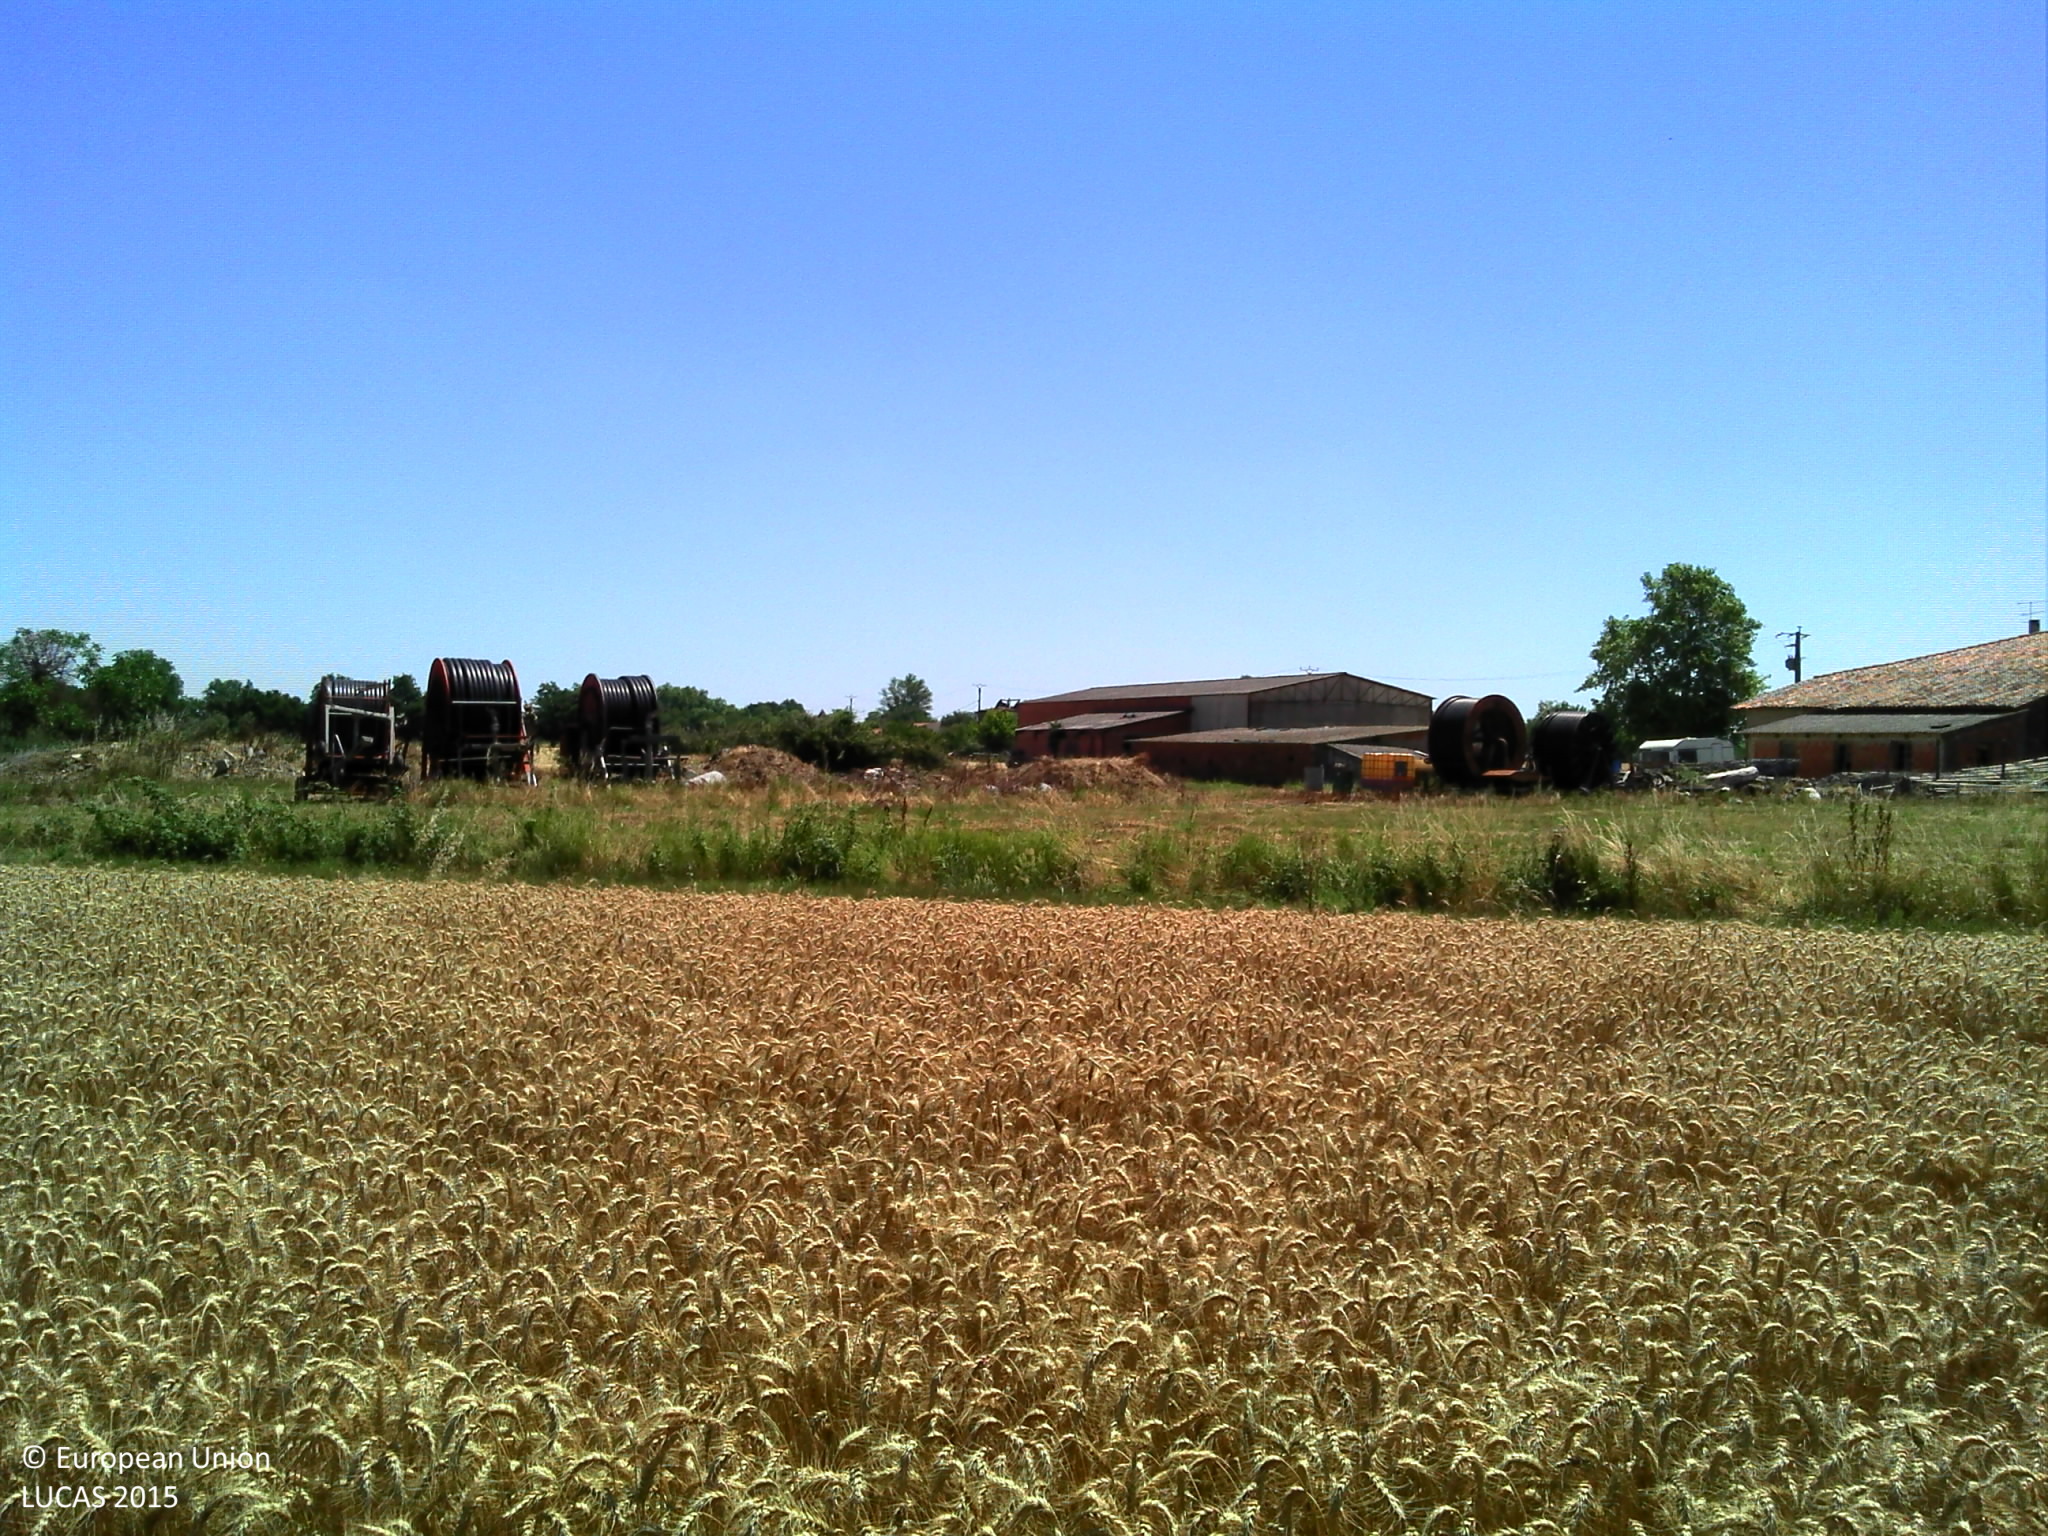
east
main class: Cropland
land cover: Durum wheat
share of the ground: > 75 %
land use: Agriculture (excluding fallow land and kitchen gardens)
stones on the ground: < 10 %
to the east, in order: Durum wheat; Ditches and canals; Grass margins; Tracks; Grass margins; Ditches and canals; Grass margins; Grassland without tree/shrub cover; Fences; Ditches and canals; Grass margins; Tracks; Grass margins; Durum wheat
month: June
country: FR
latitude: 43.7485
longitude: 1.2957
